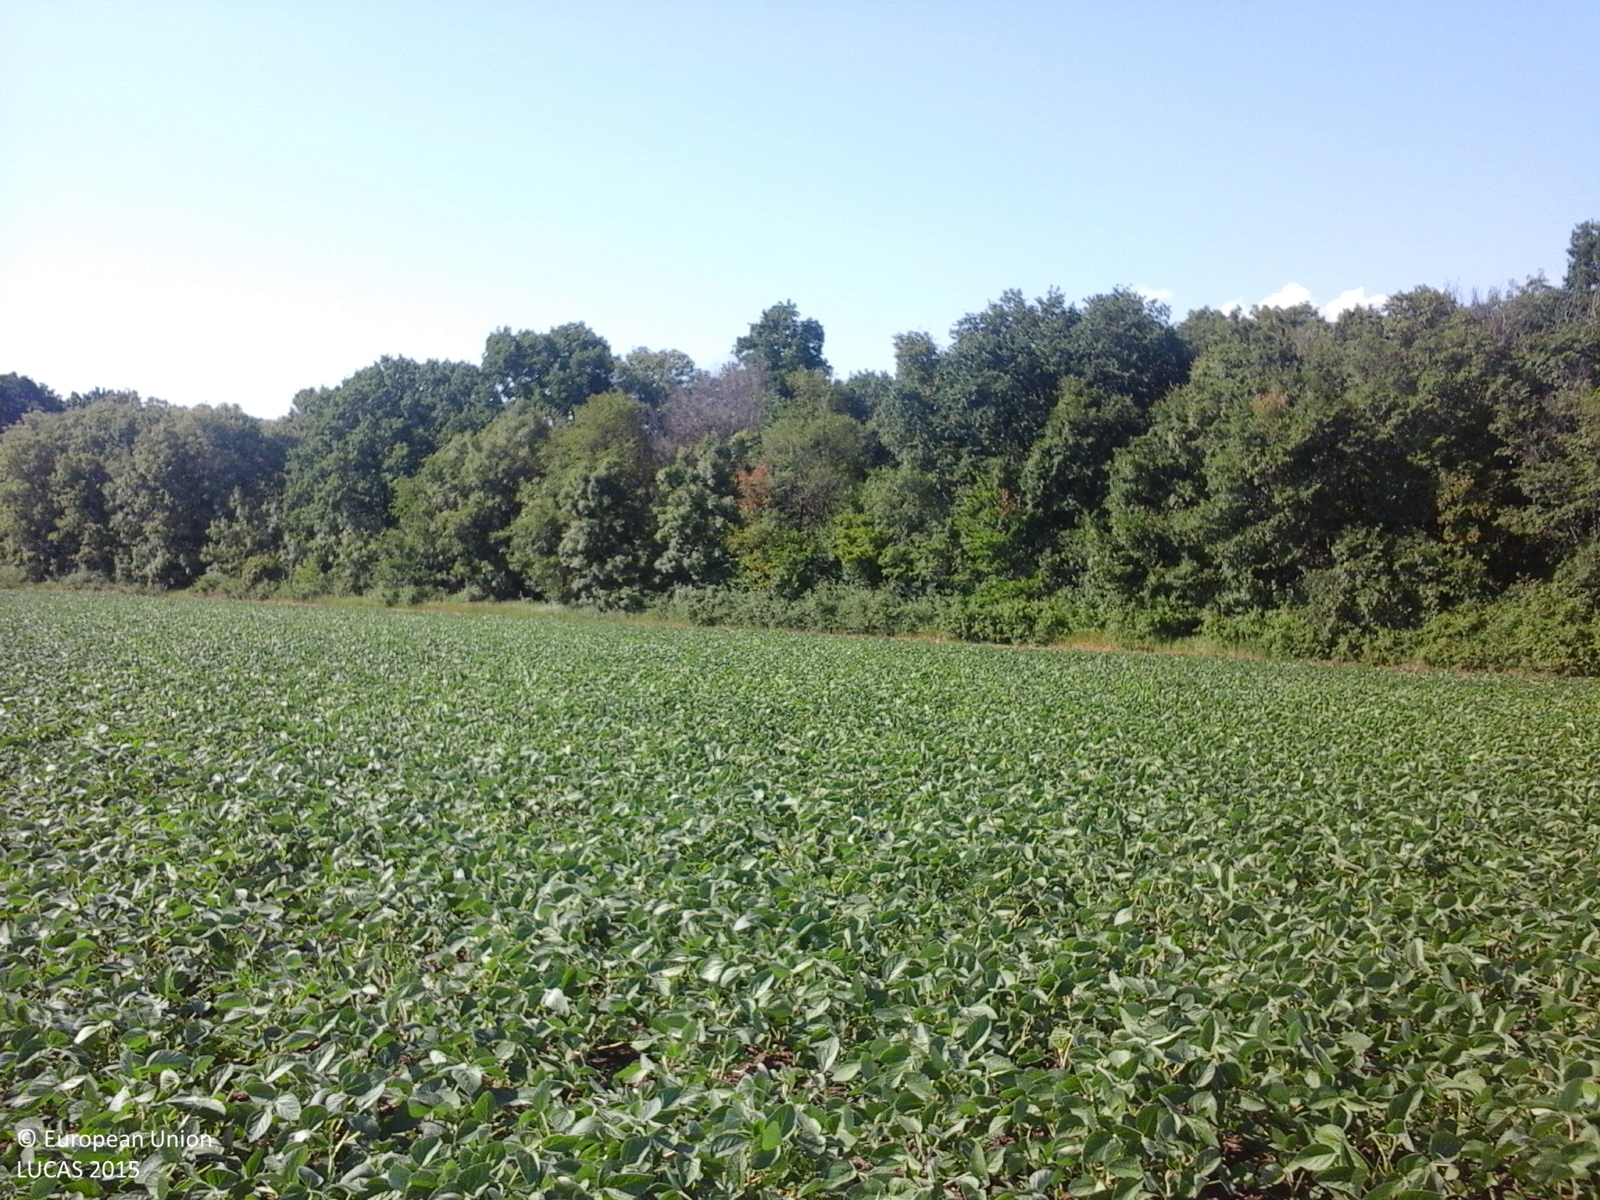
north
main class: Cropland
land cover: Soya
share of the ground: 50 - 75 %
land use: Agriculture (excluding fallow land and kitchen gardens)
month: June
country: RO
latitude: 47.4085
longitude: 27.4363
